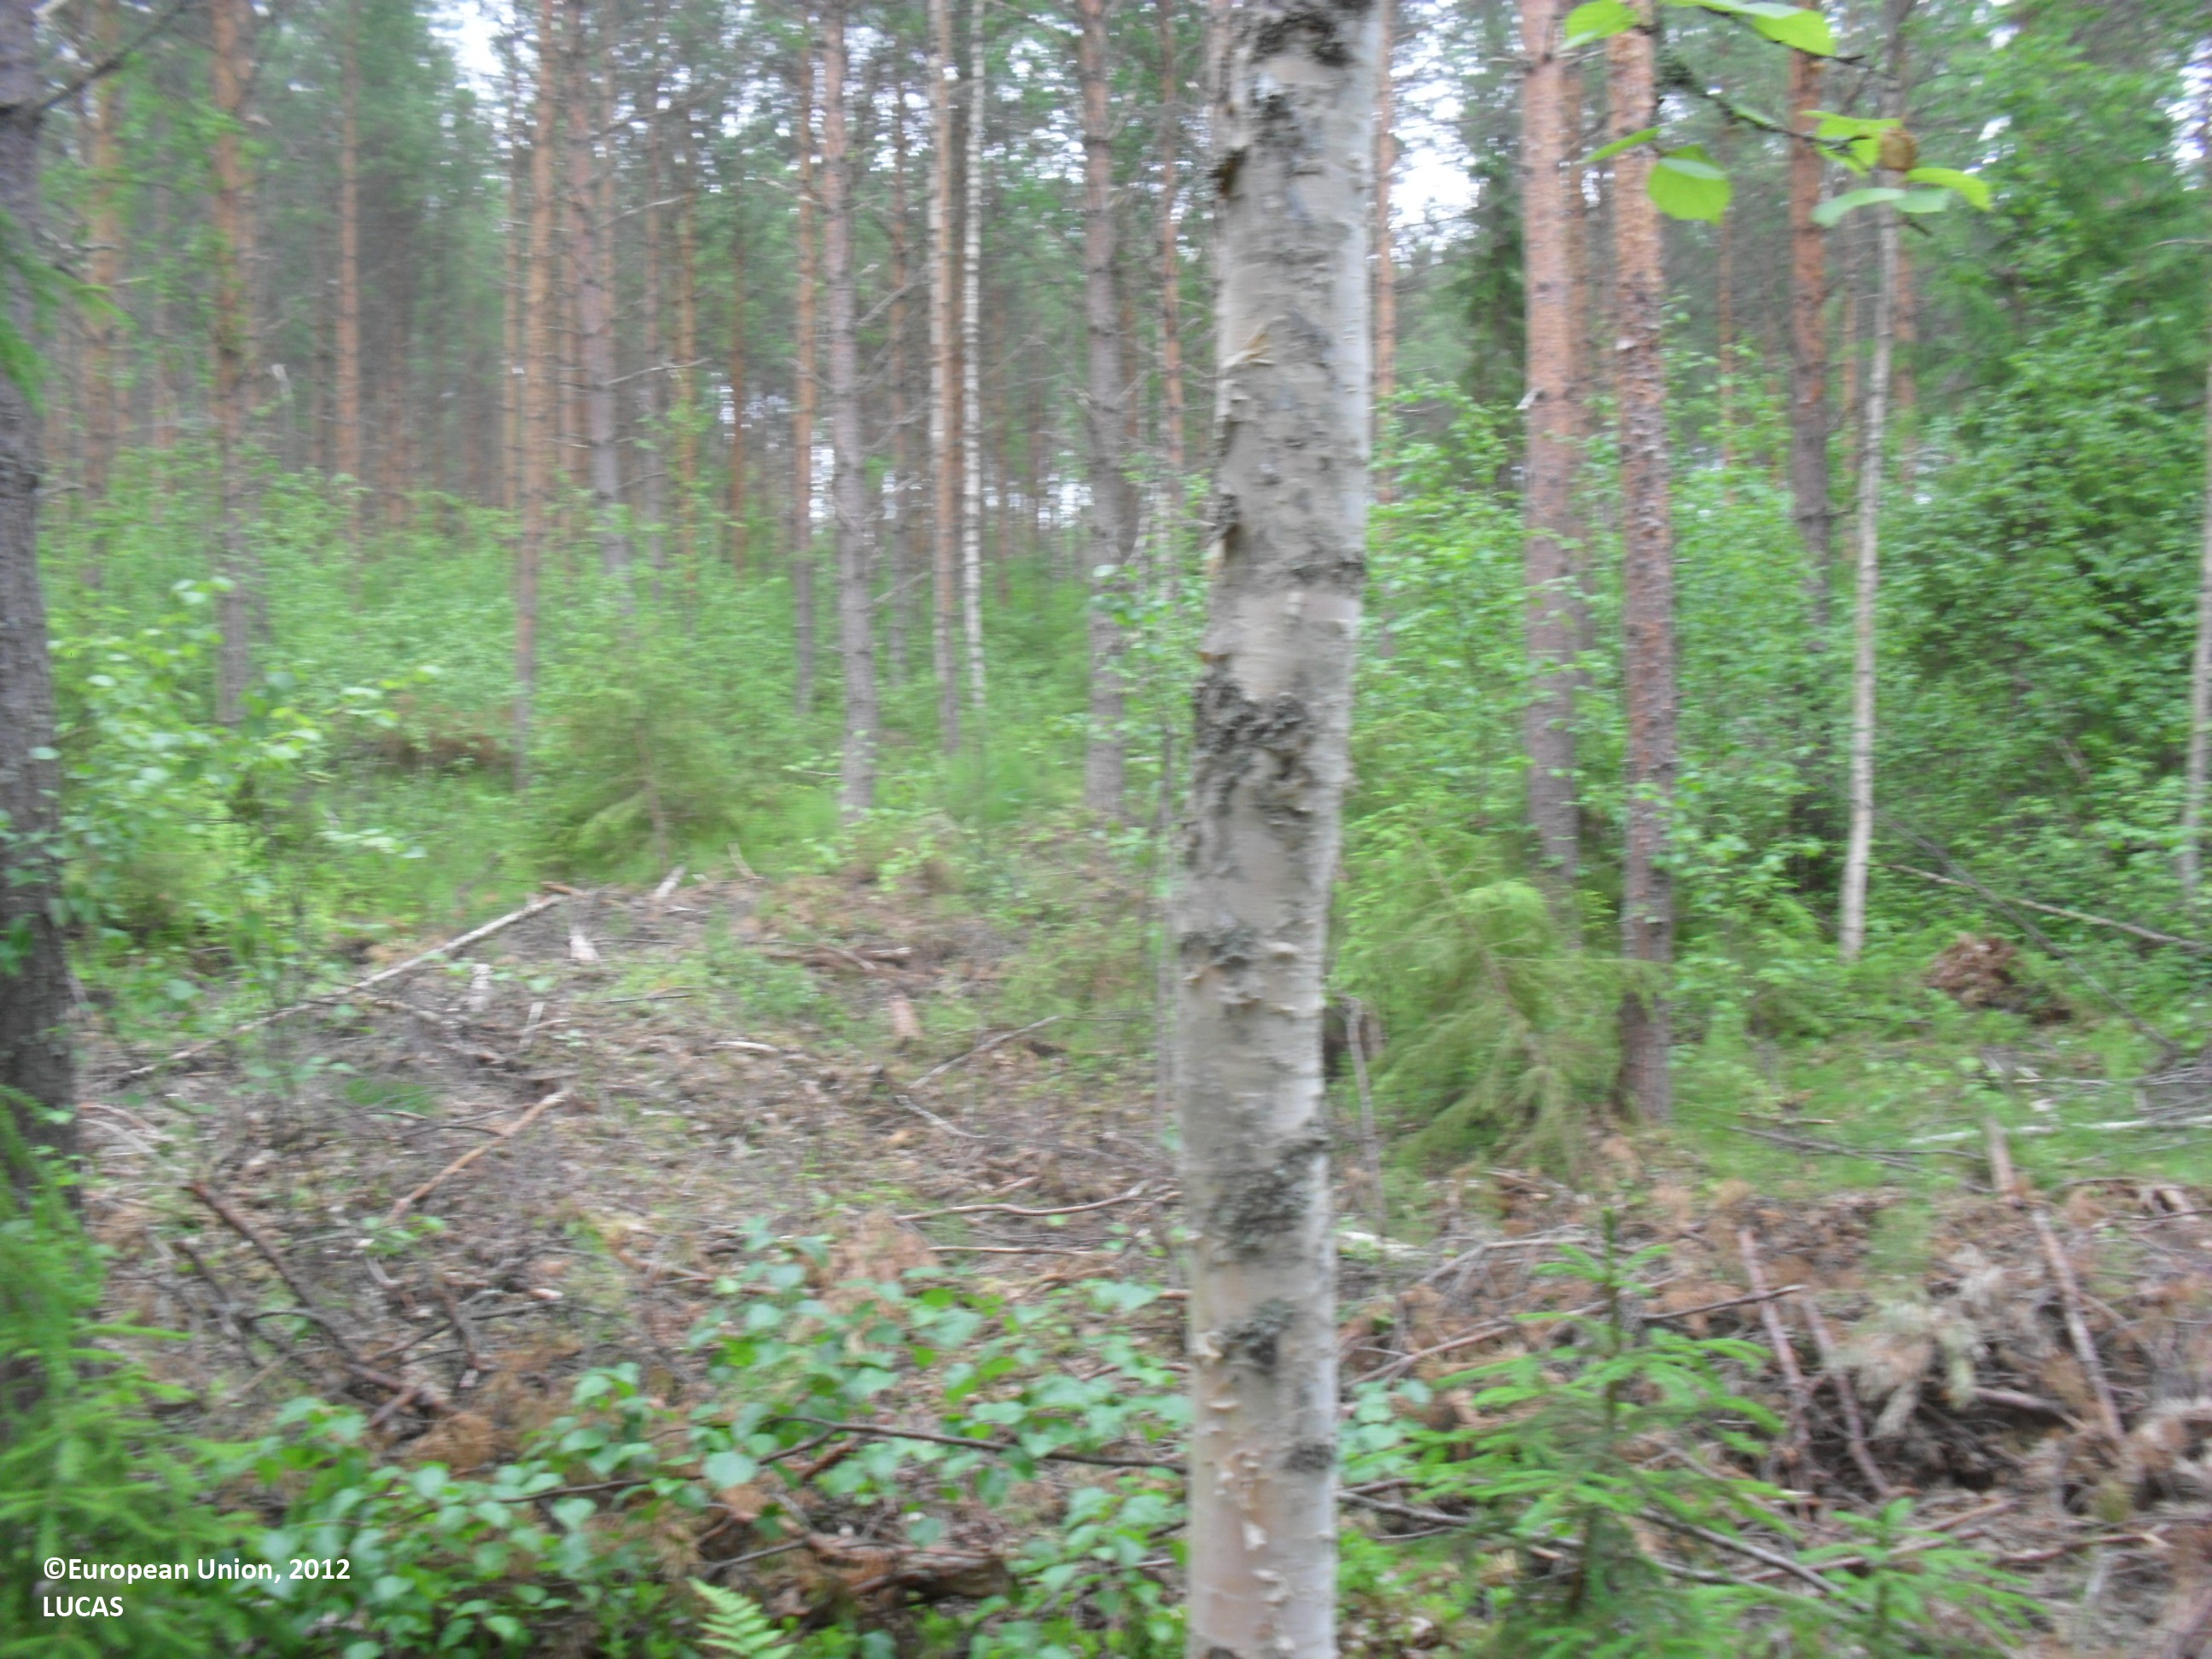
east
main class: Woodland
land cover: Other mixed woodland
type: boreal forest
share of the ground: 50 - 75 %
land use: Forestry
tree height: > 5 m
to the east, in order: Other mixed woodland; Tracks; Other mixed woodland; Tracks; Other mixed woodland; Tracks; Pine dominated mixed woodland; Tracks; Other mixed woodland; Ditches and canals; Grass margins; Paved roads, cycling and walking lanes; Spontaneously vegetated surfaces; Ditches and canals; Other mixed woodland; Tracks; Other mixed woodland; Pine dominated mixed woodland; Grassland with sparse tree/shrub cover; Other mixed woodland
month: June
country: FI
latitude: 62.9804
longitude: 23.6237
